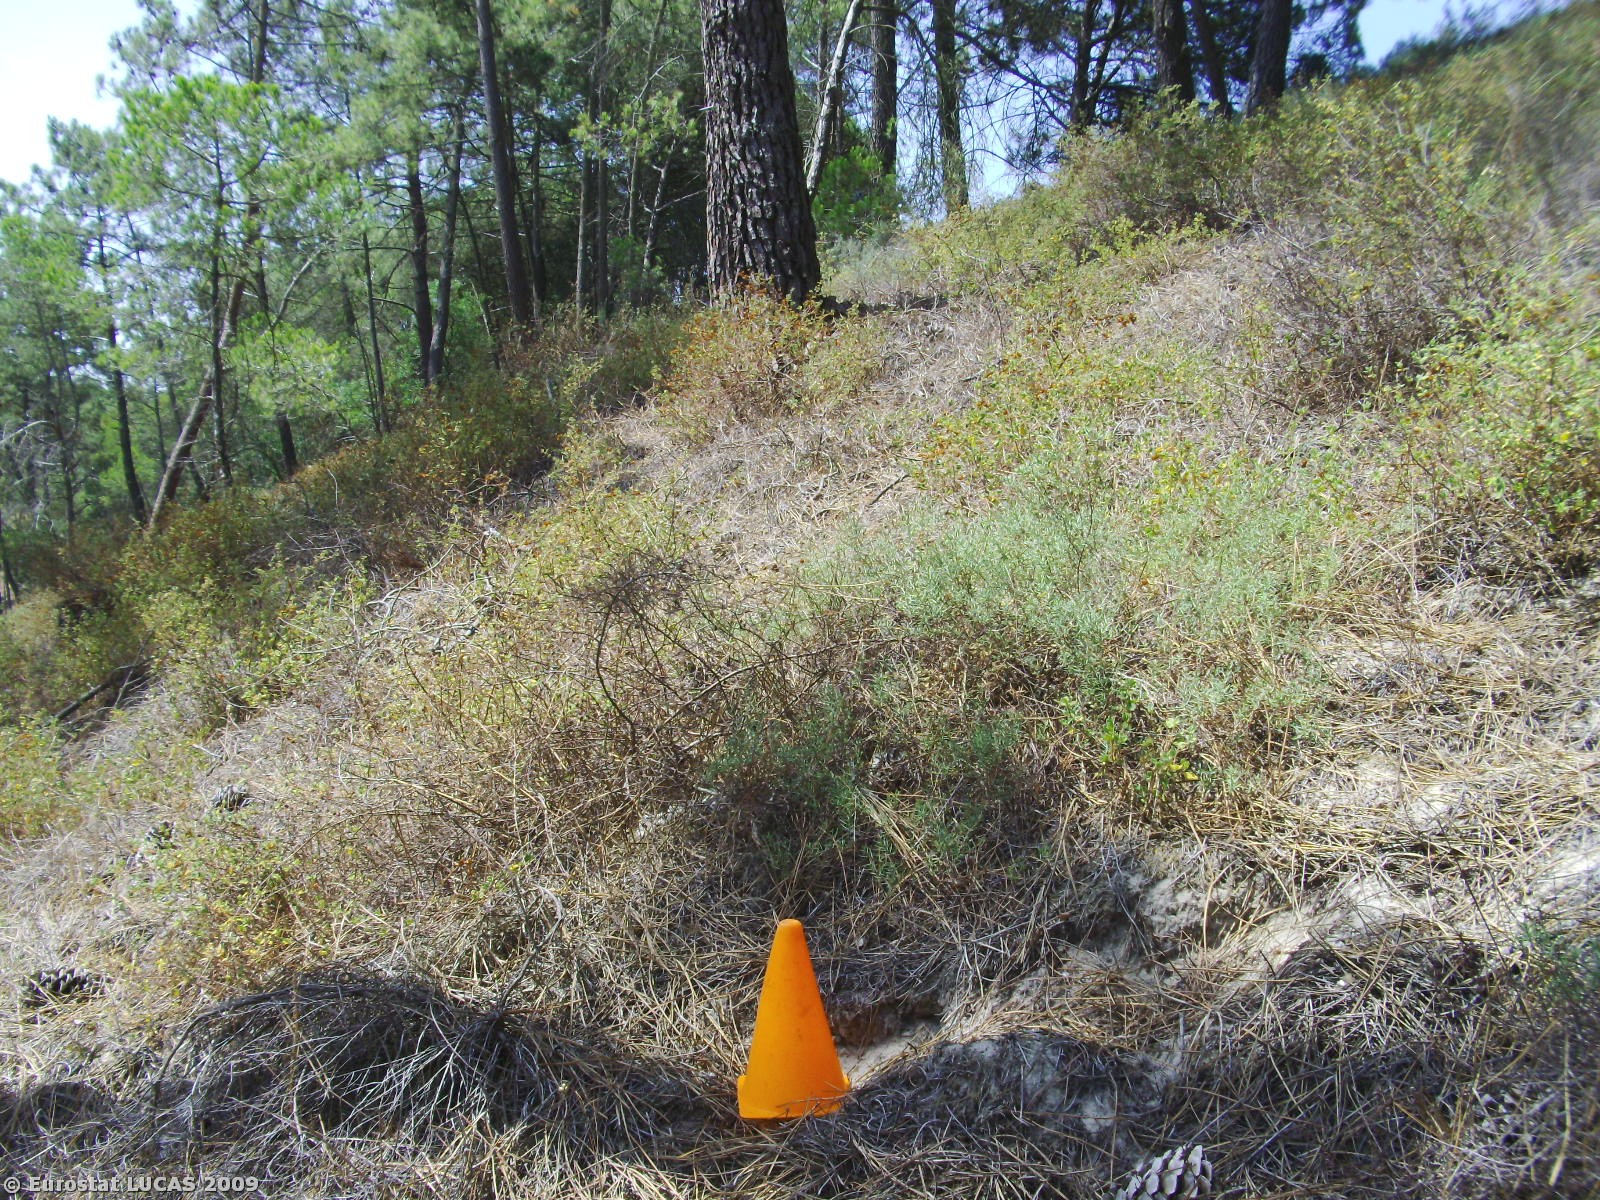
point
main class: Woodland
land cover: Coniferous woodland
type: coniferous forest of the mediterranean region
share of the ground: 25 - 50 %
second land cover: Spontaneously vegetated surfaces
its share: 50 - 75 %
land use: Forestry
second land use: Unused
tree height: > 5 m
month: July
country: PT
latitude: 38.5587
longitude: -9.1801
